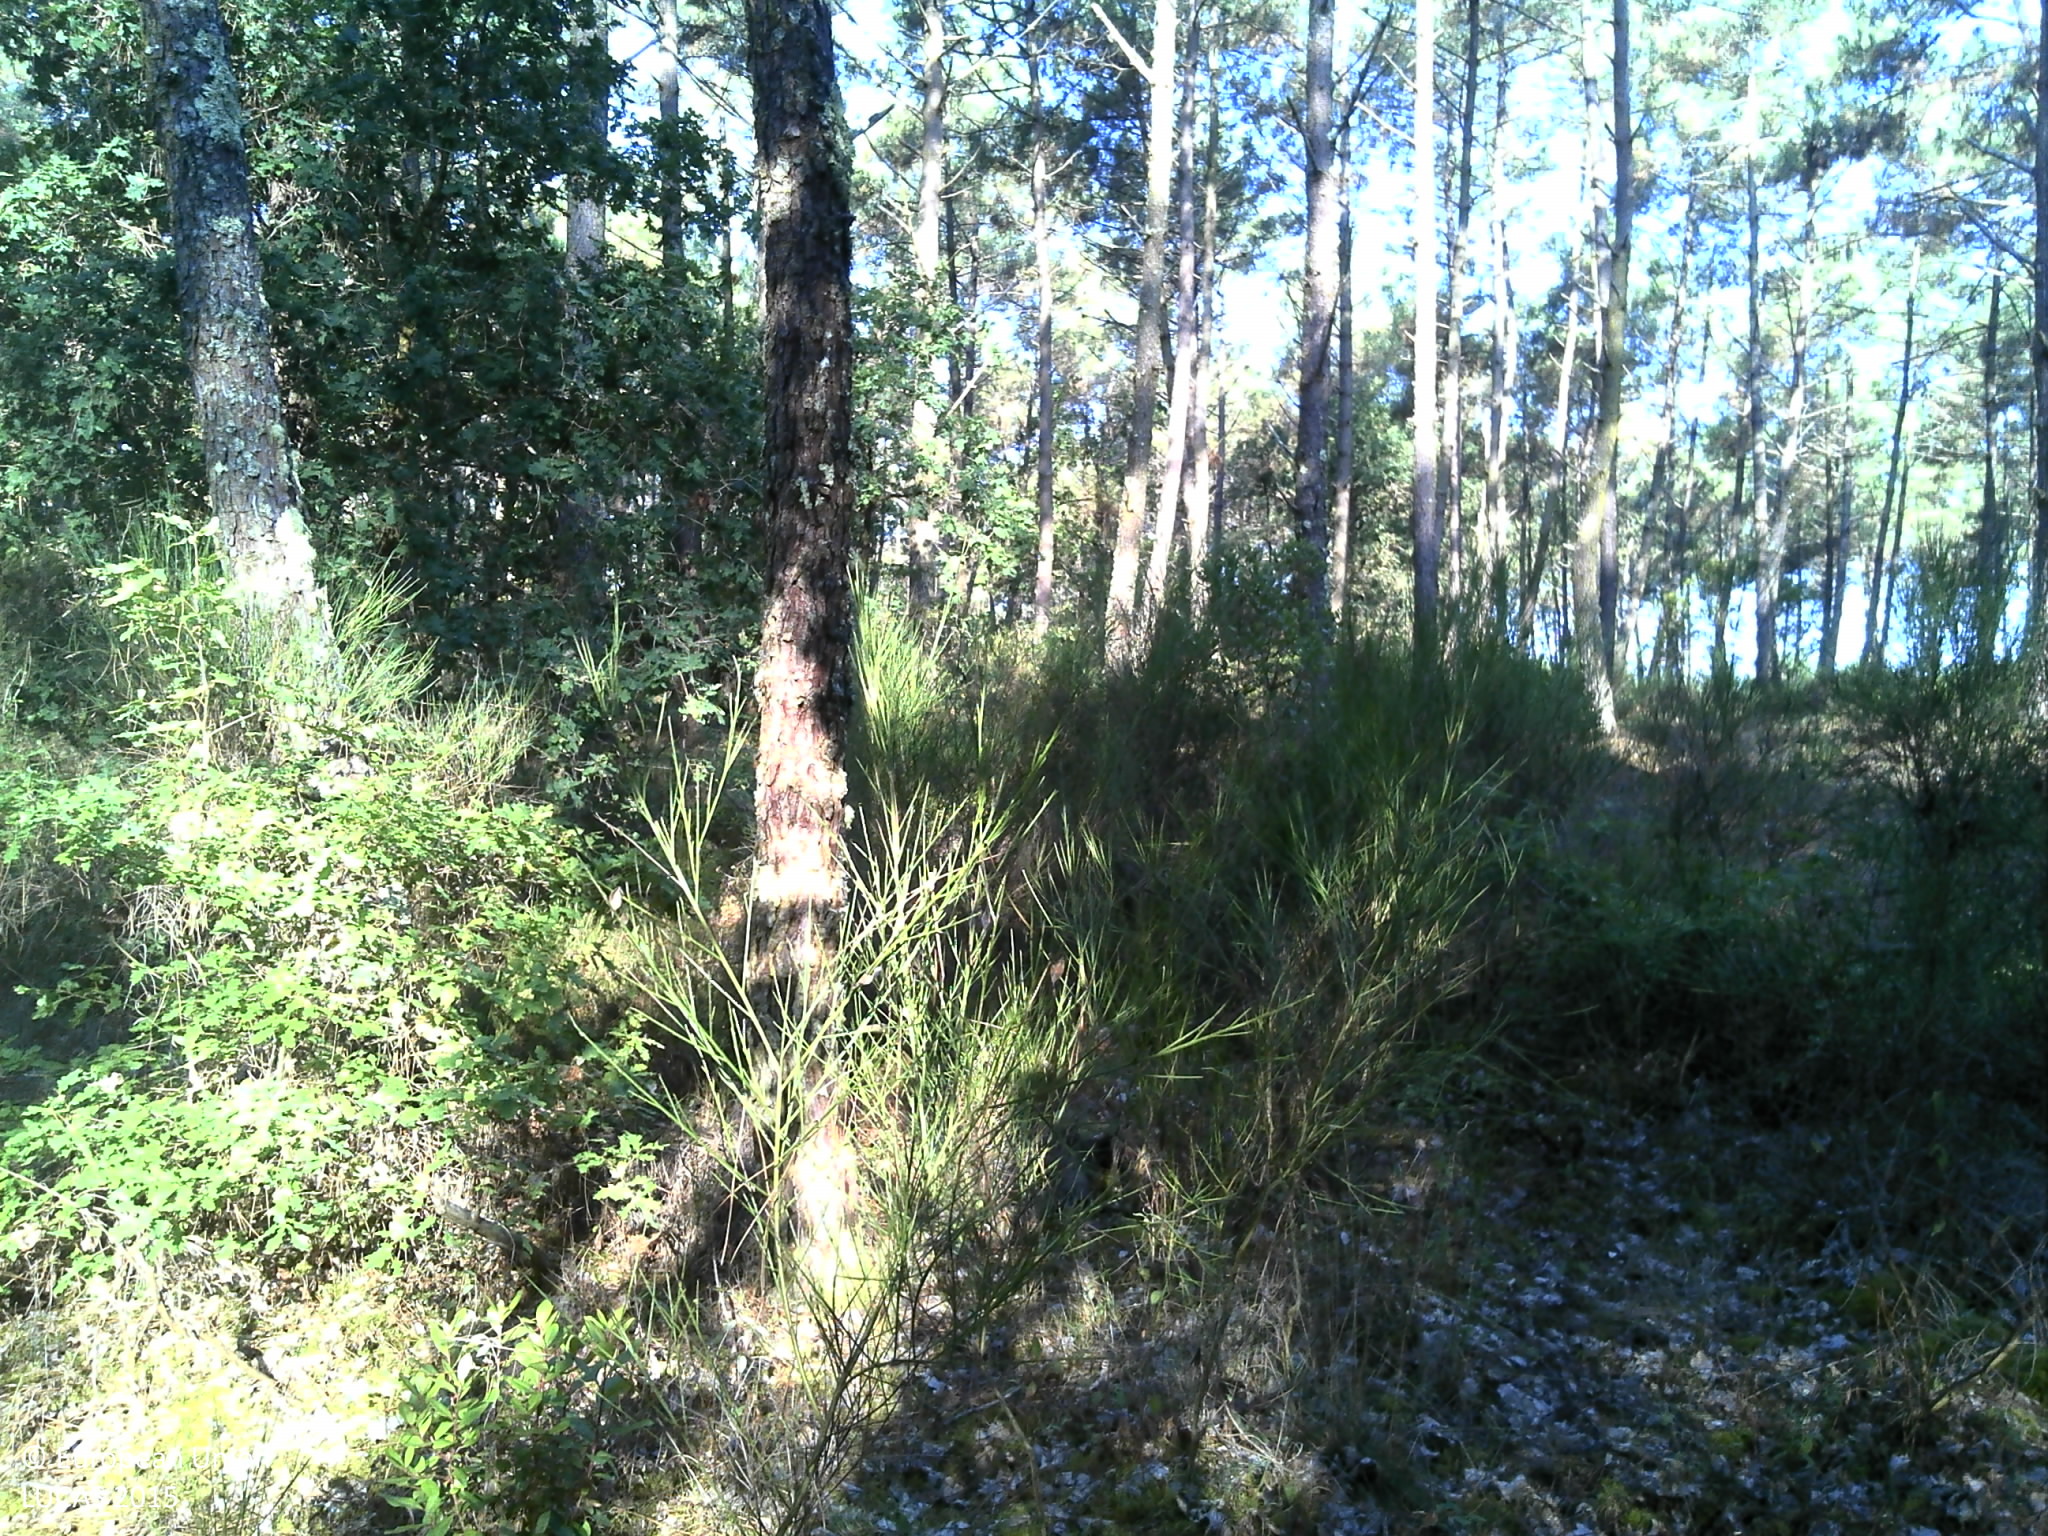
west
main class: Woodland
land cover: Broadleaved woodland
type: coniferous forest of the mediterranean region
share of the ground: > 75 %
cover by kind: broadleaved forest trees 50 %, shrubs 30 %, coniferous forest trees 10 %, herbaceous plants 5 %, lichens and mosses 5 %
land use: Forestry
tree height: > 5 m
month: August
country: FR
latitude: 44.7988
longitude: -1.1870
